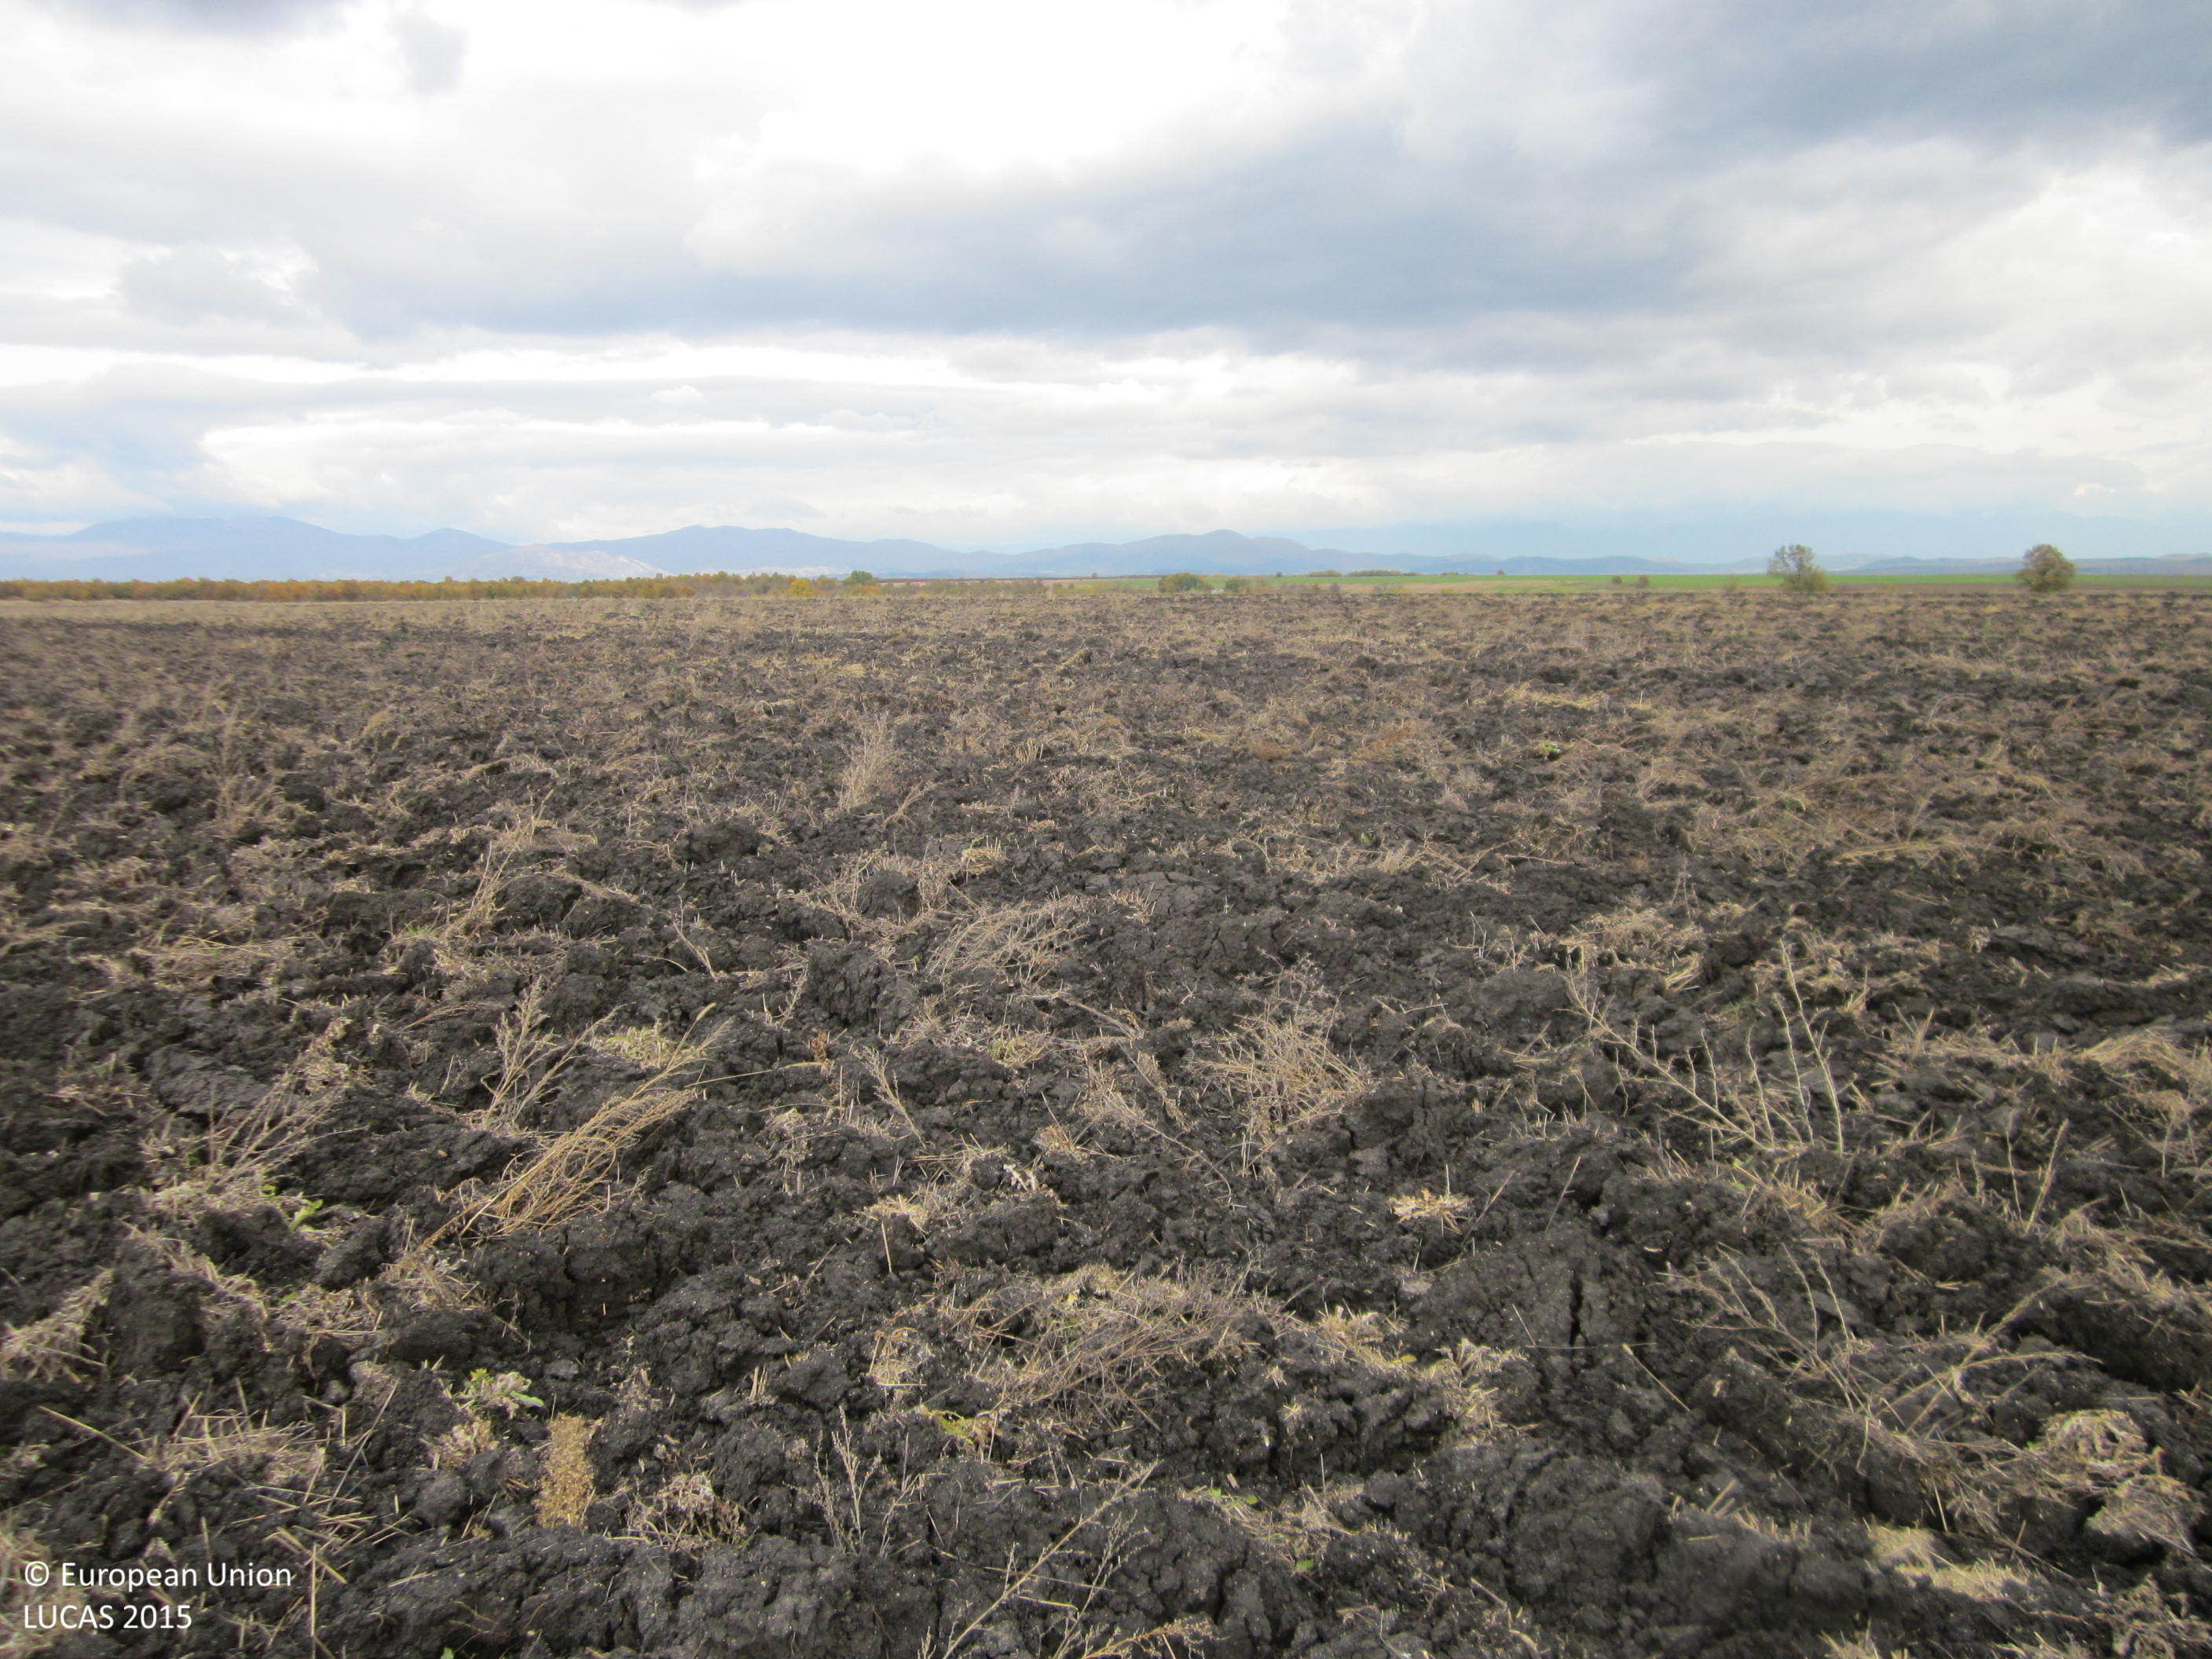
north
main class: Cropland
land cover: Common wheat
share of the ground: < 10 %
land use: Agriculture (excluding fallow land and kitchen gardens)
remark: Harvested field
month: November
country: BG
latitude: 42.3685
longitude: 24.6606
